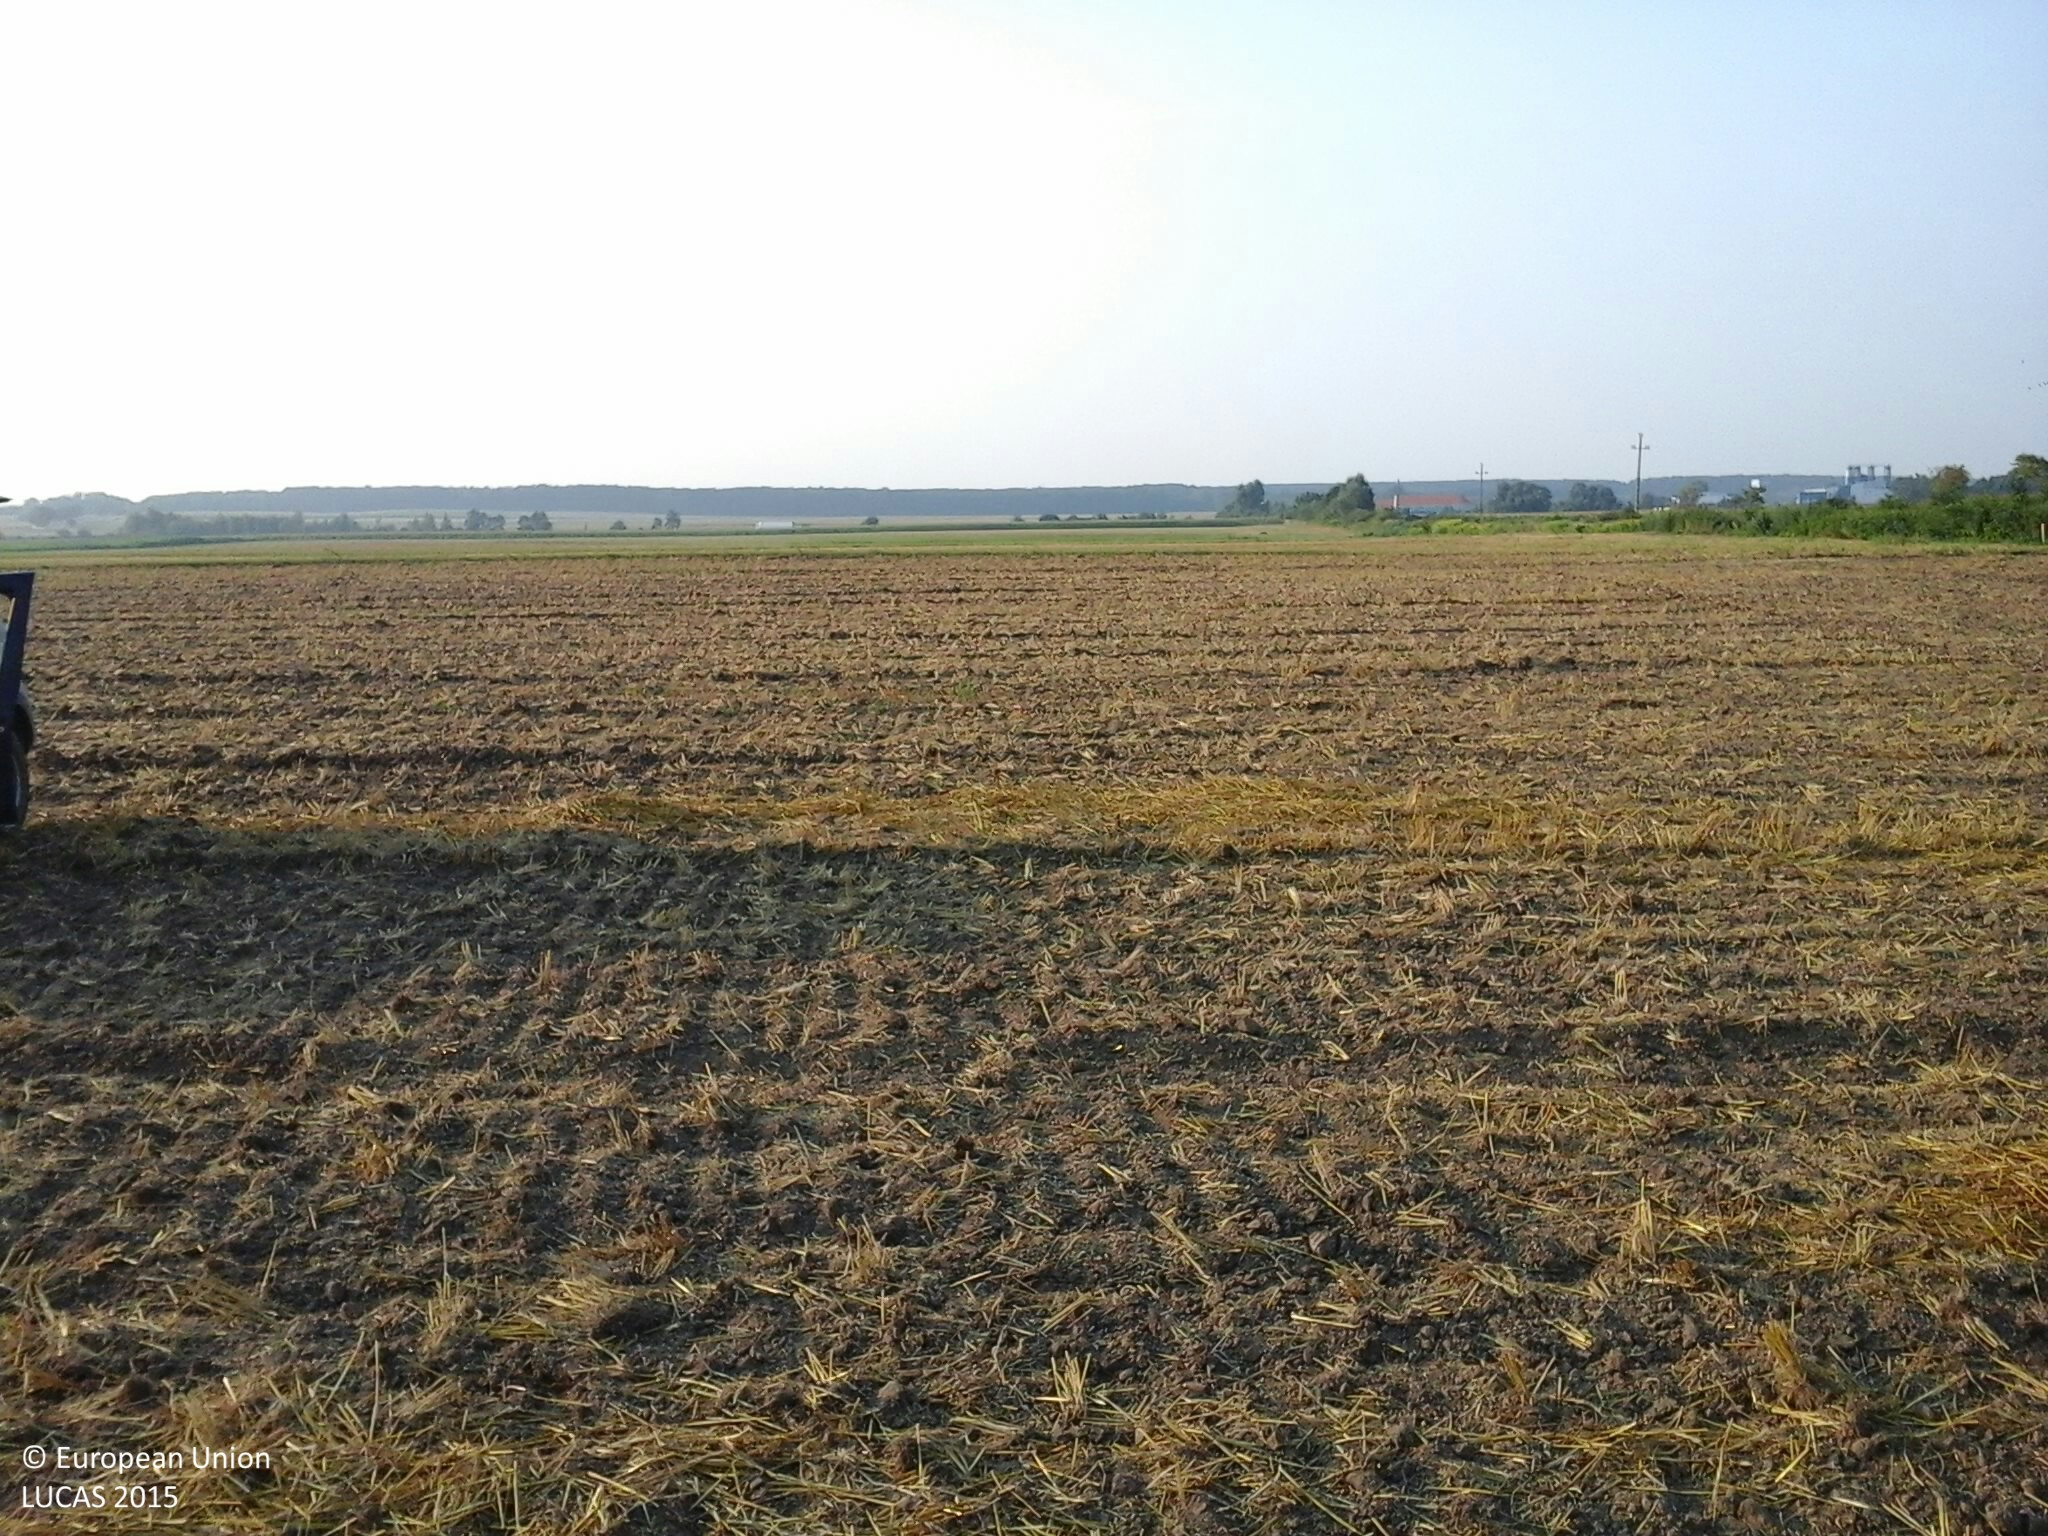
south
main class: Cropland
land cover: Triticale
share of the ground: < 10 %
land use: Agriculture (excluding fallow land and kitchen gardens)
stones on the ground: < 10 %
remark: Harvested field
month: August
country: HU
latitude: 47.1249
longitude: 17.1366
